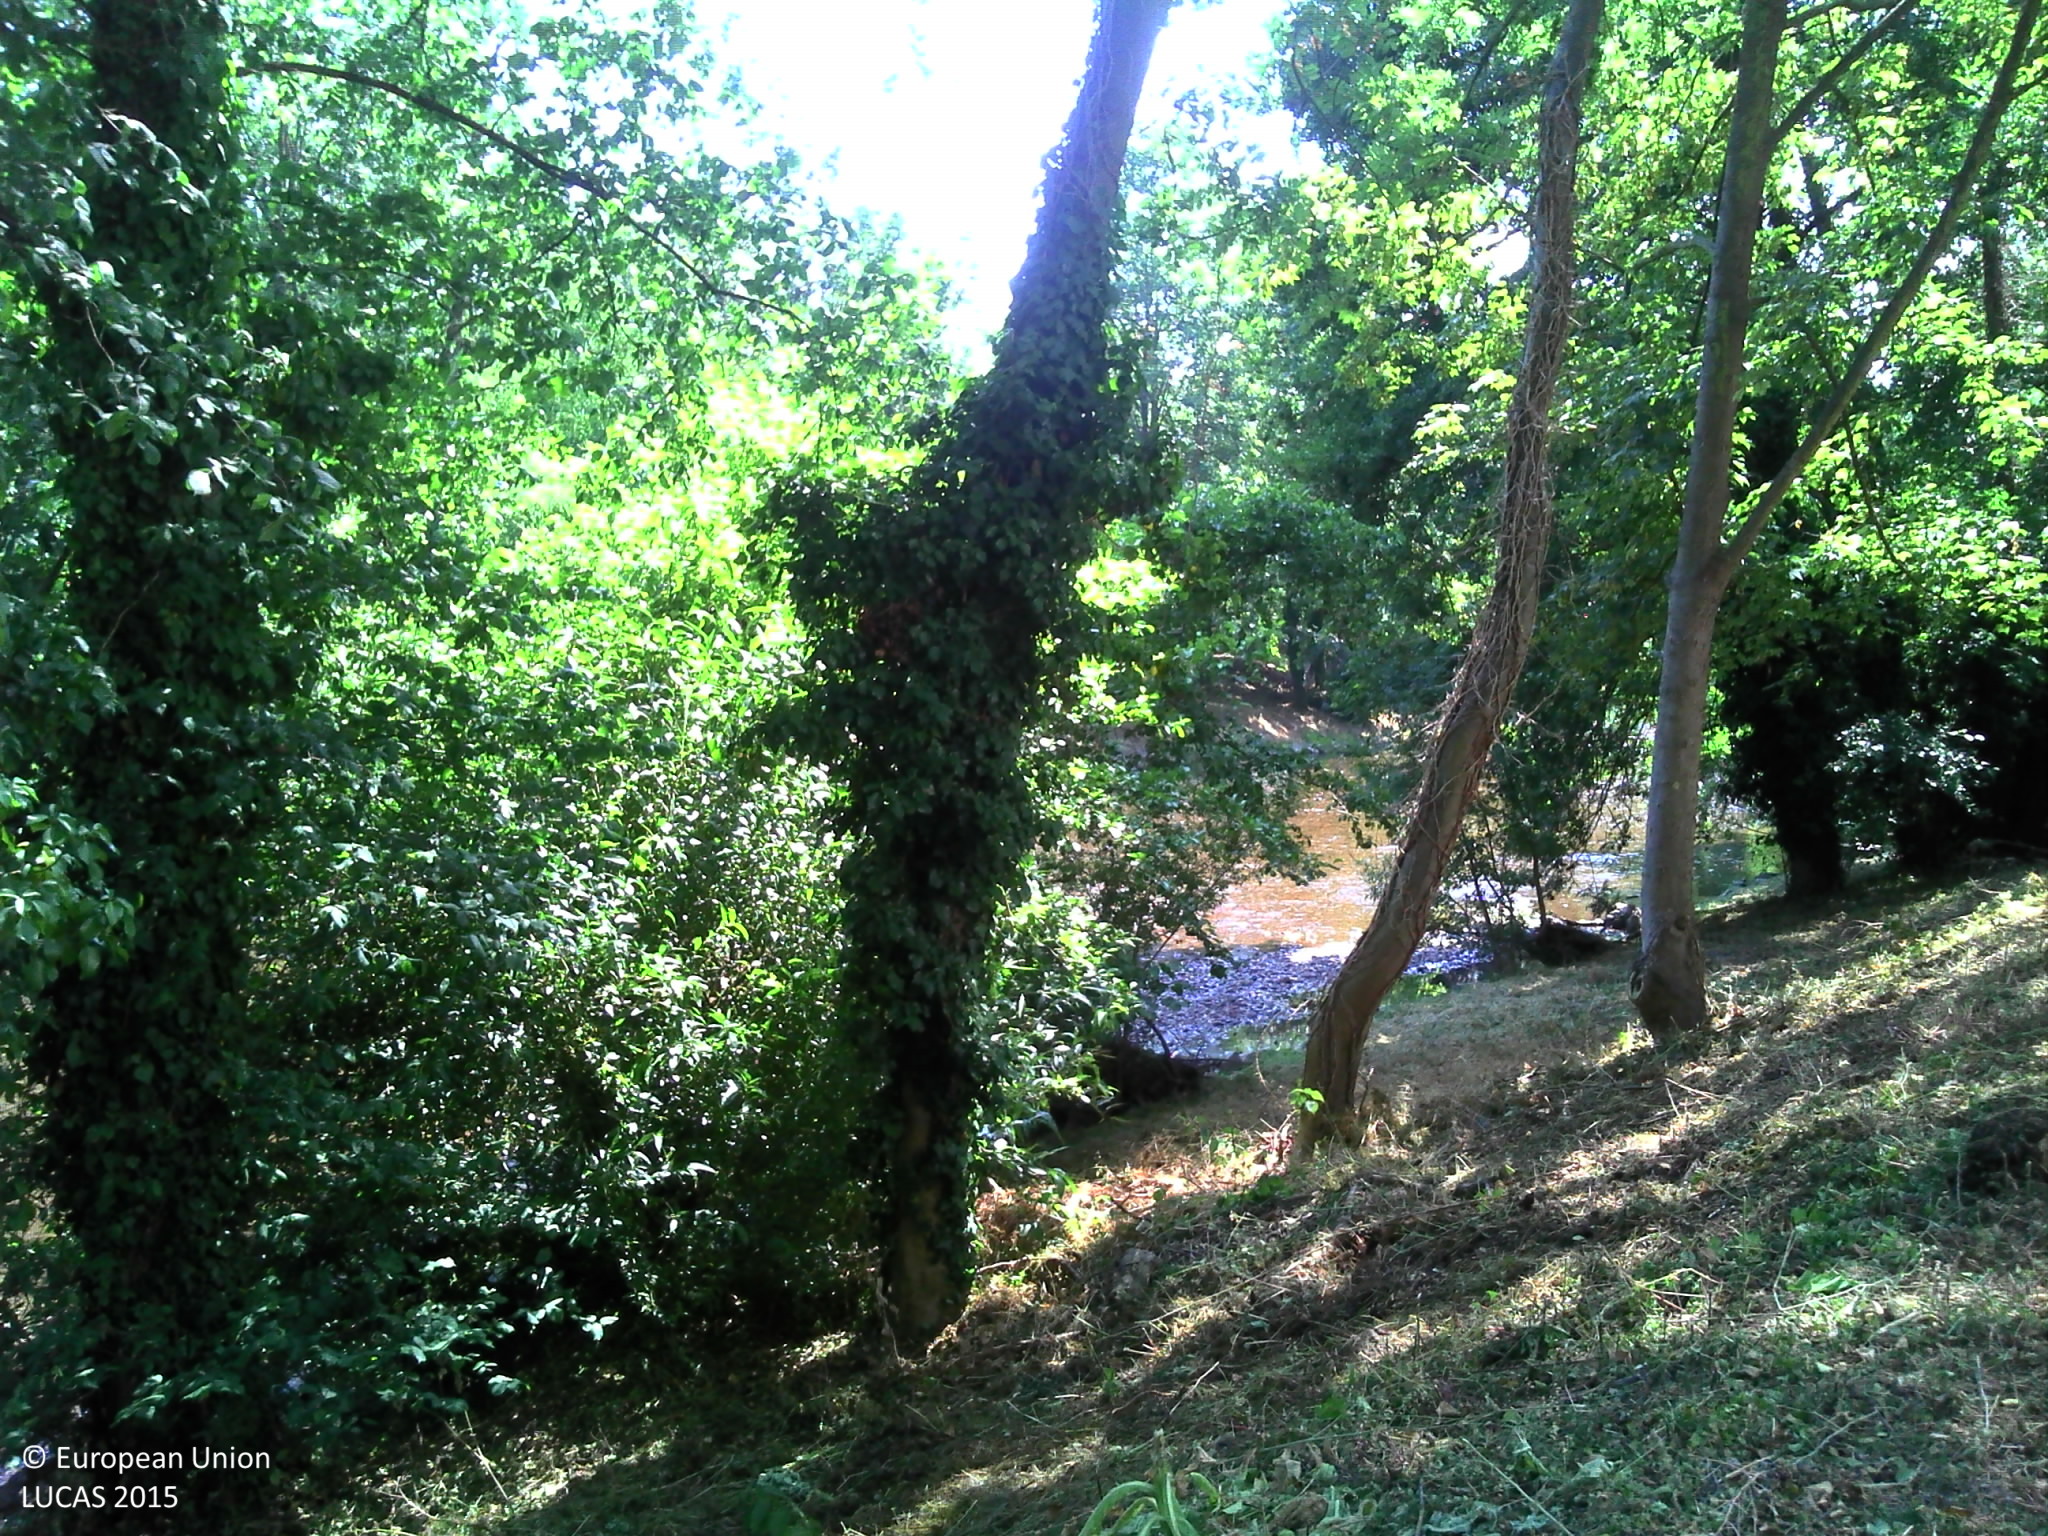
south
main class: Woodland
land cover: Broadleaved woodland
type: floodplain forest
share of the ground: > 75 %
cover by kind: broadleaved forest trees 80 %, herbaceous plants 15 %, coniferous forest trees 5 %
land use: Residential
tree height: > 5 m
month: July
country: FR
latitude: 48.5371
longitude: 7.4953
